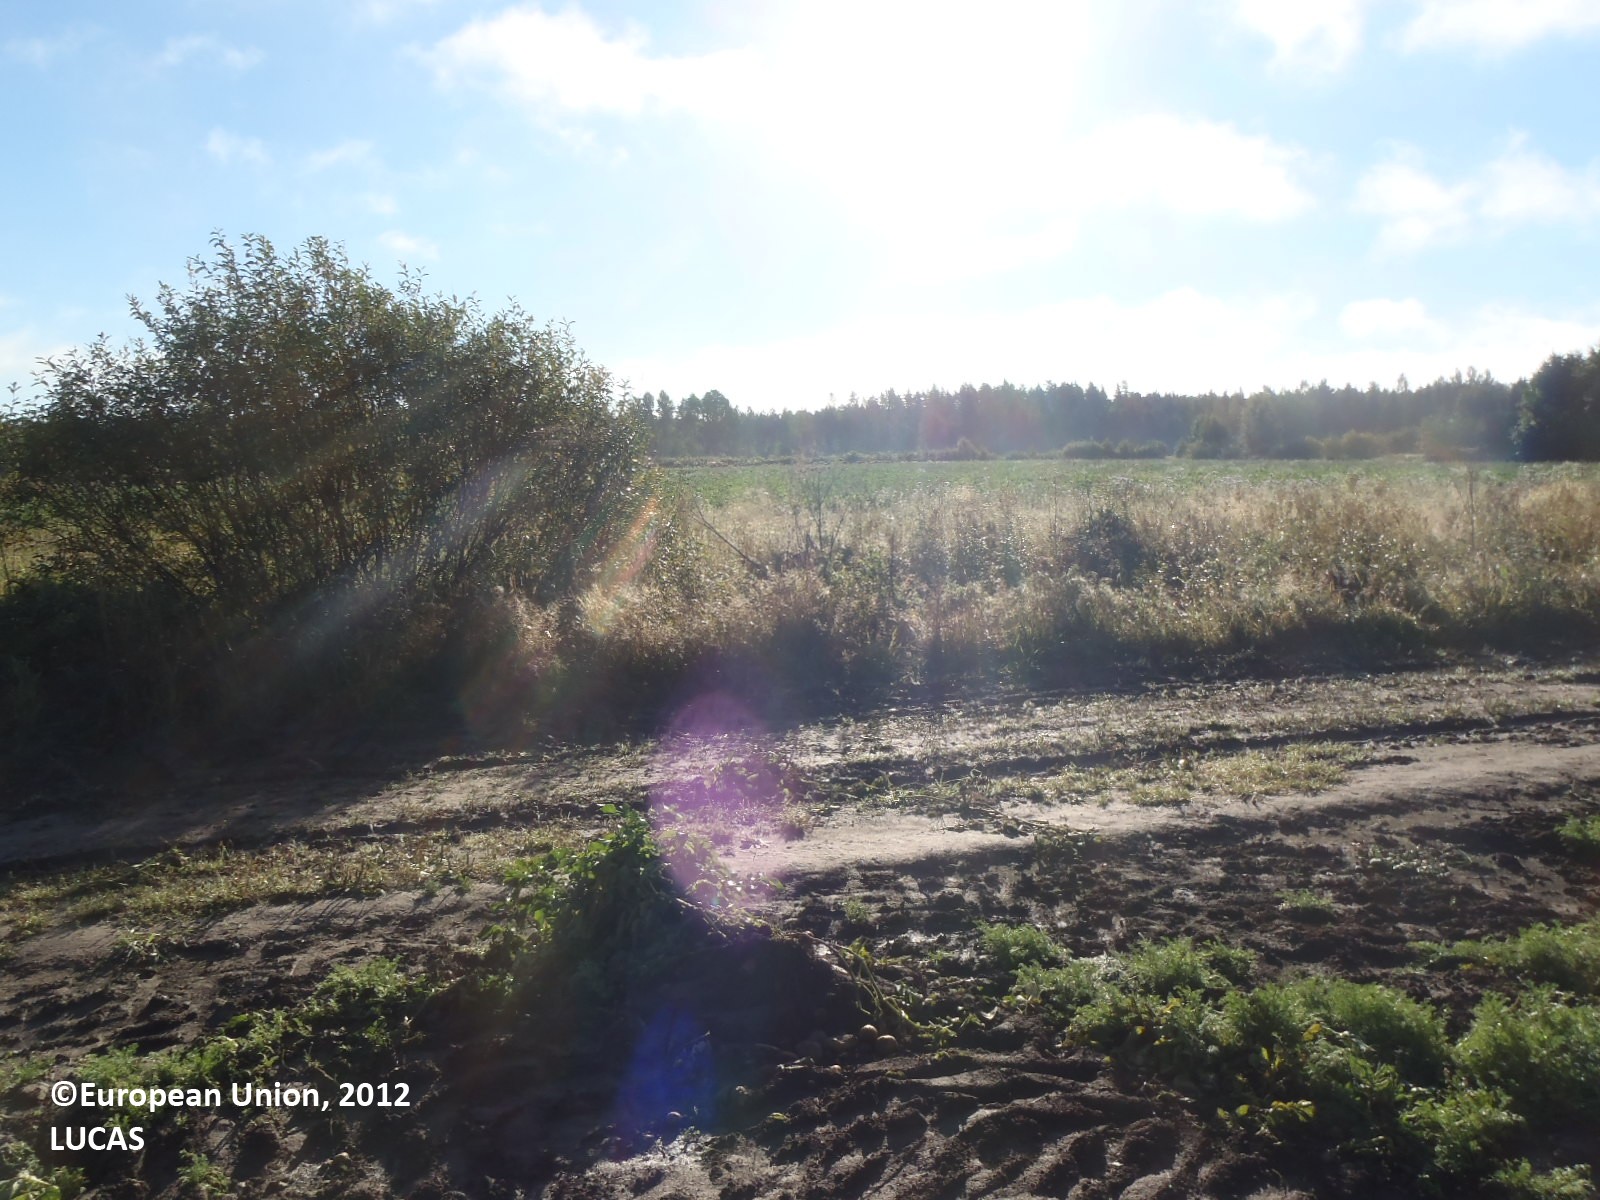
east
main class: Cropland
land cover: Potatoes
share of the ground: 50 - 75 %
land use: Agriculture (excluding fallow land and kitchen gardens)
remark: Harvested field
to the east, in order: Potatoes; Tracks; Grass margins; Ditches and canals; Grass margins; Grassland without tree/shrub cover; Rape and turnip rape; Grassland without tree/shrub cover; Grass margins; Ditches and canals; Electric lines; Potatoes
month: September
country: FI
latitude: 61.0537
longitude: 22.4197
